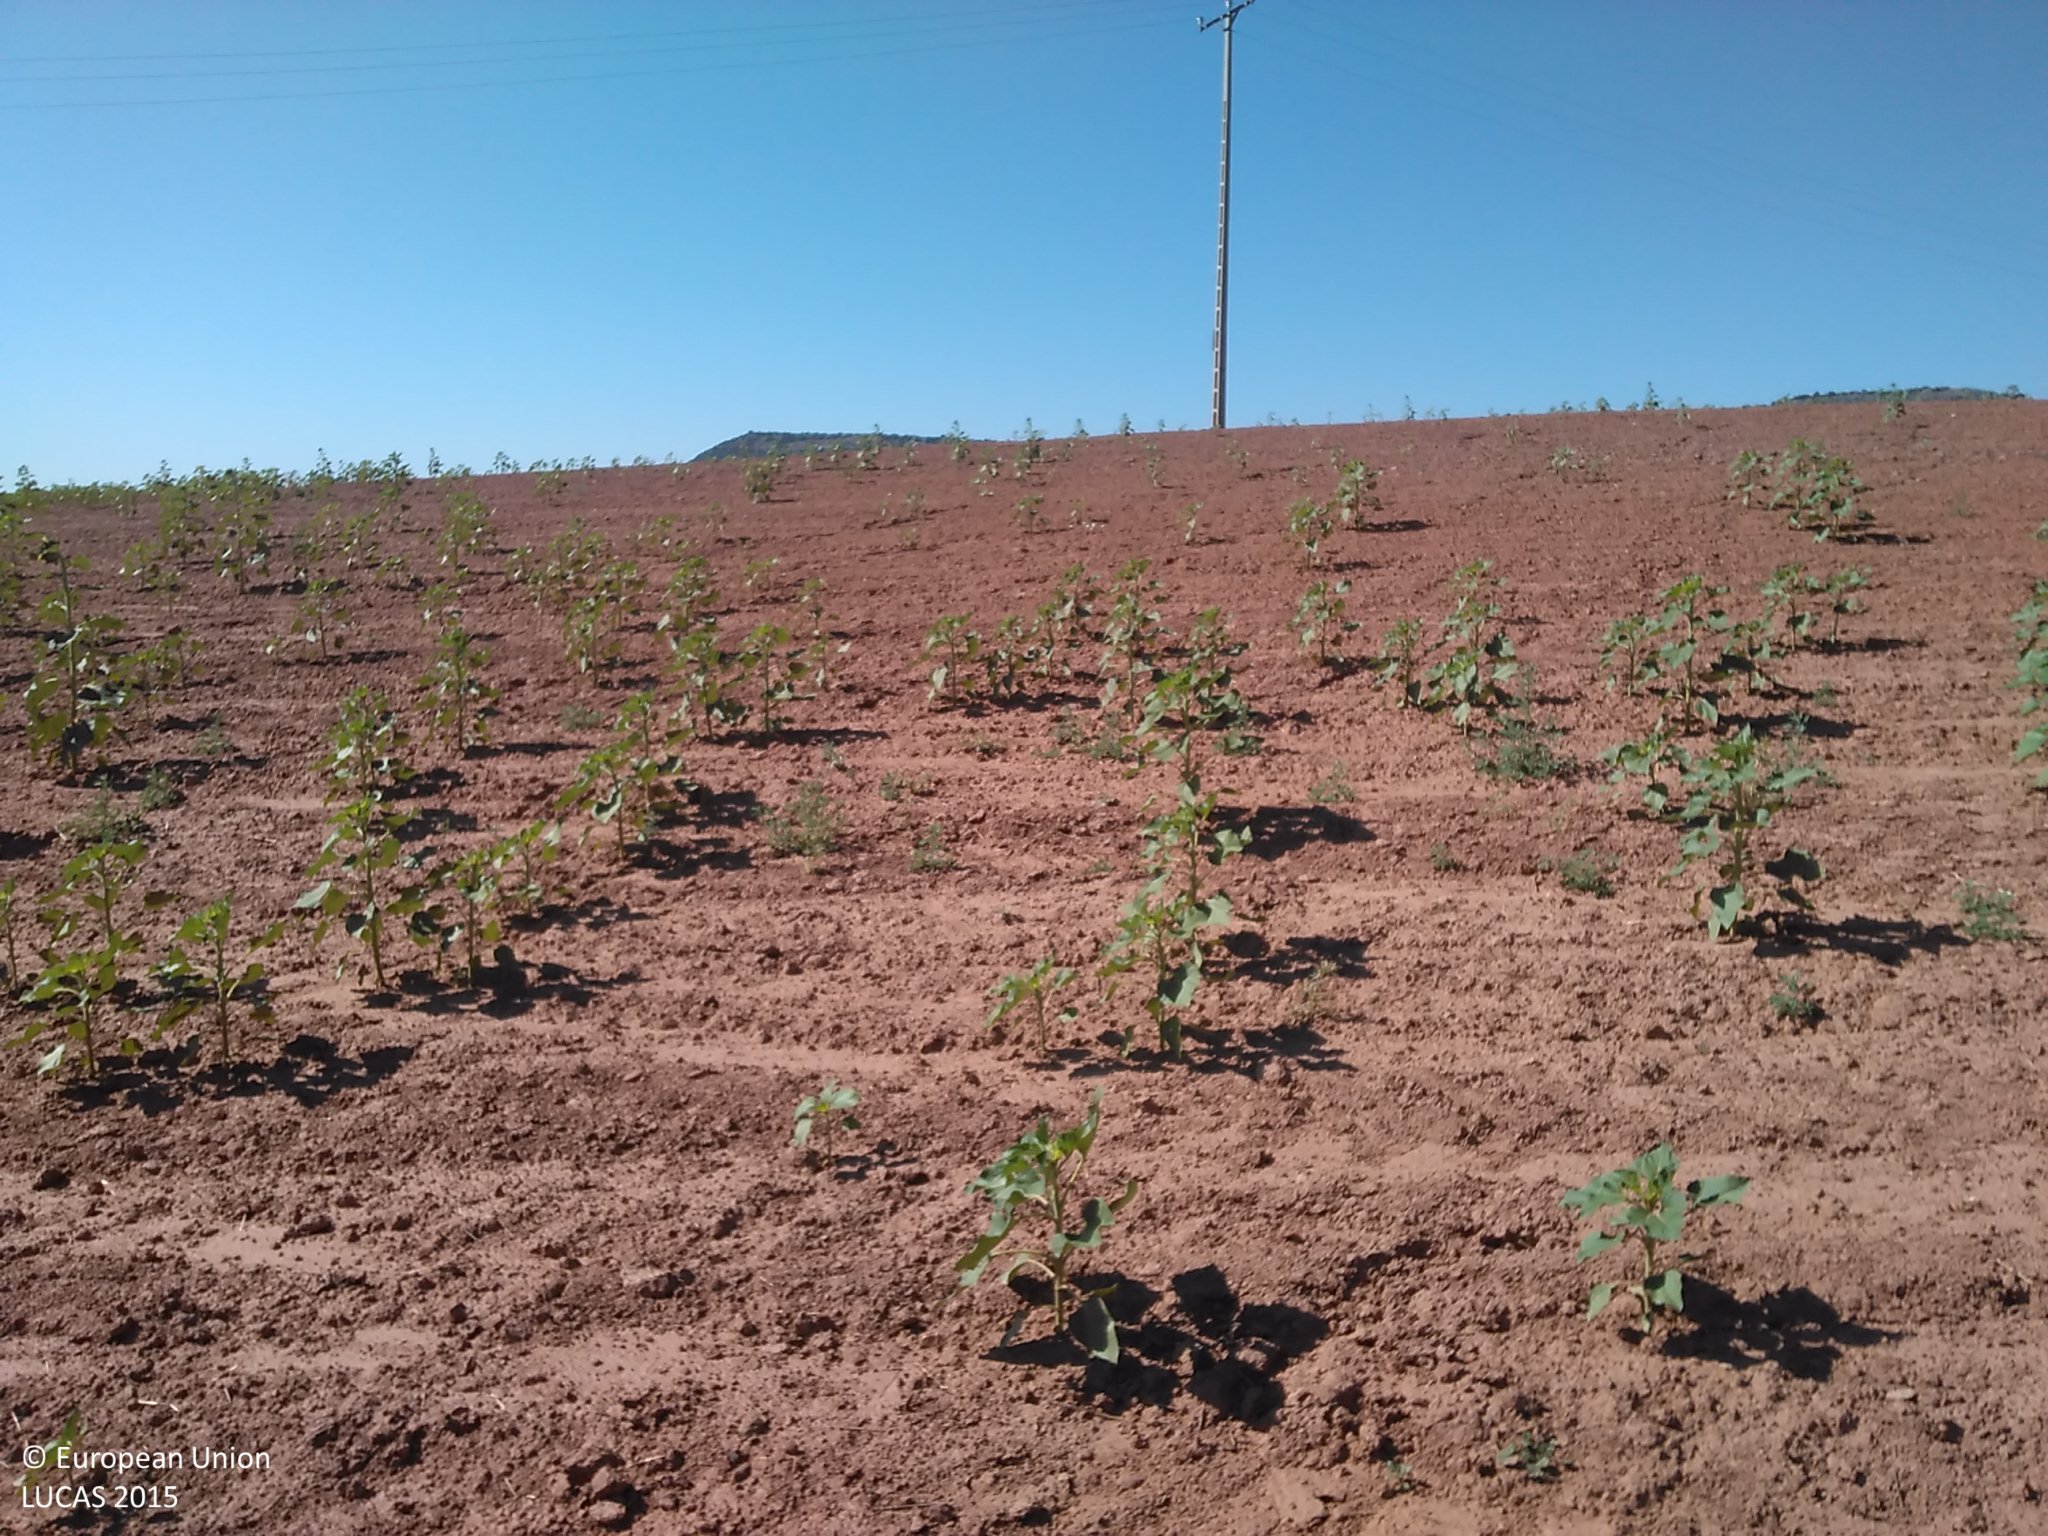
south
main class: Cropland
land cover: Sunflower
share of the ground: 10 - 25 %
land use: Agriculture (excluding fallow land and kitchen gardens)
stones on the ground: < 10 %
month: July
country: ES
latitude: 41.5153
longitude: -2.0249
